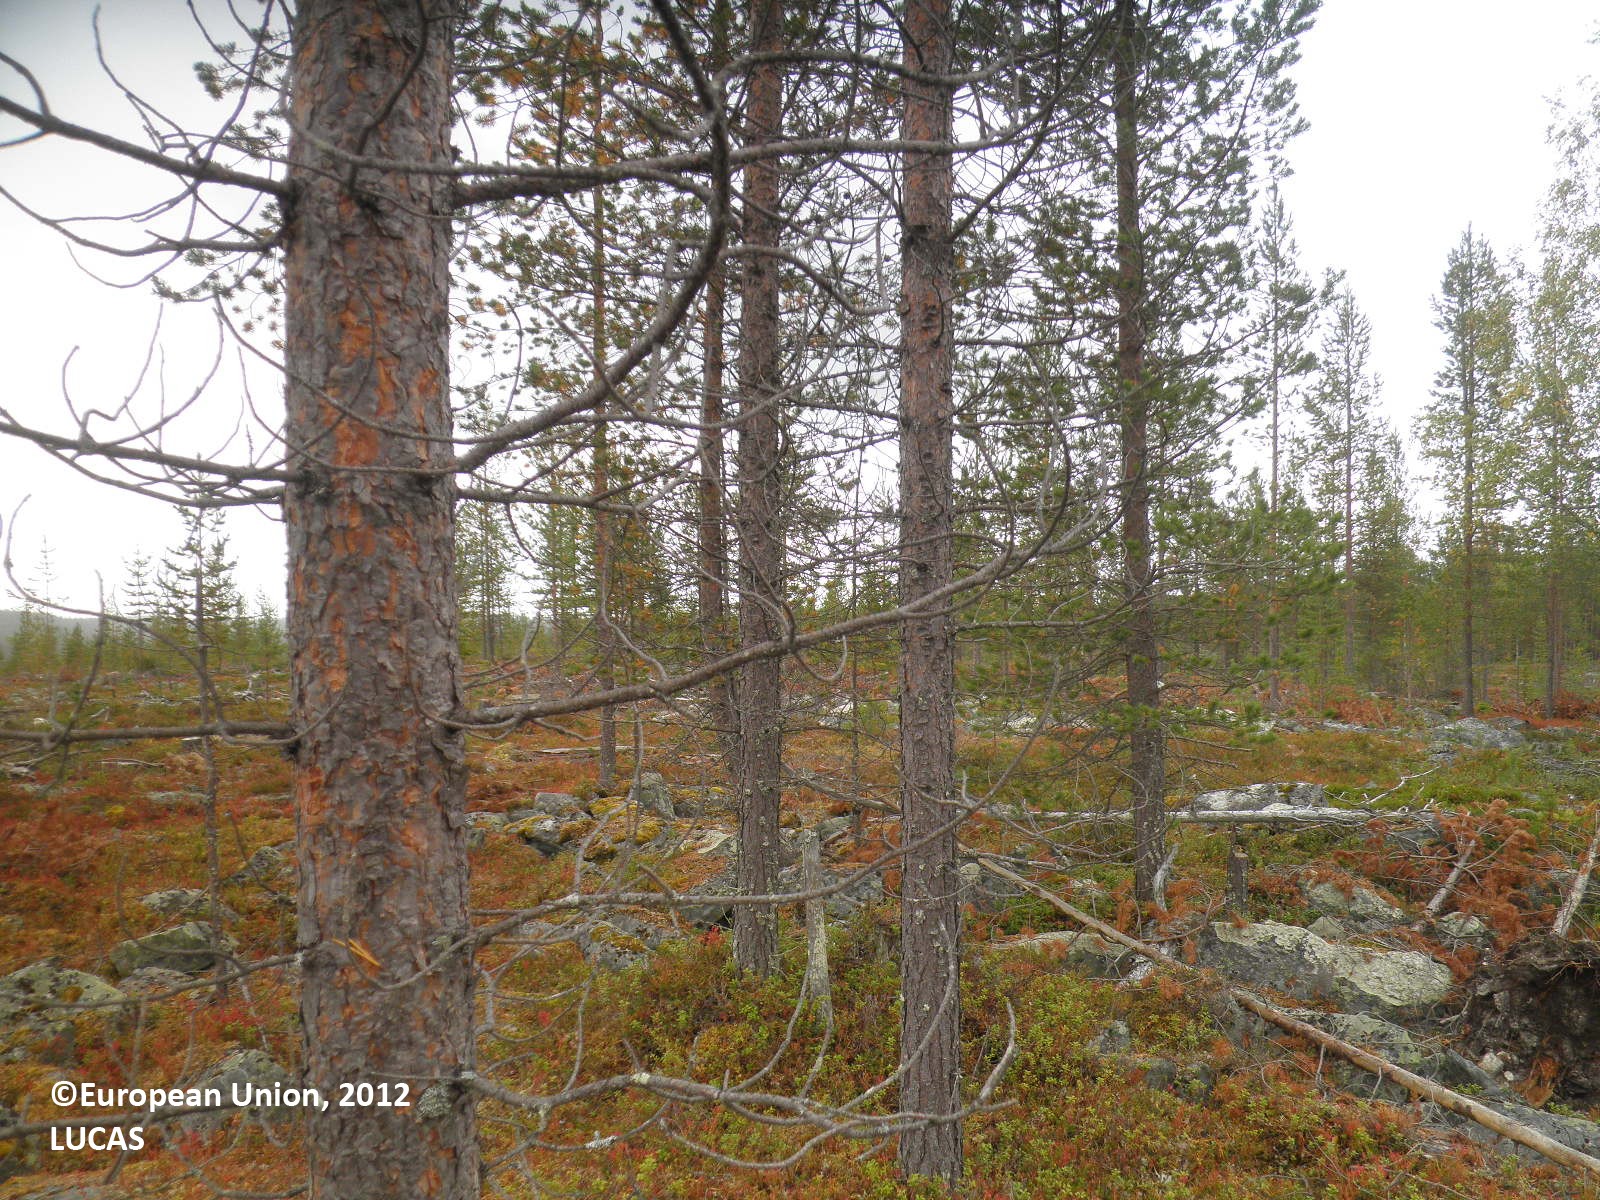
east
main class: Woodland
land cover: Pine dominated coniferous woodland
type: boreal forest
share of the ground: 10 - 25 %
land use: Forestry
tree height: > 5 m
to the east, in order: Pine dominated coniferous woodland; Shrubland with sparse tree cover
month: September
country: FI
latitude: 67.4335
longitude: 28.6522
